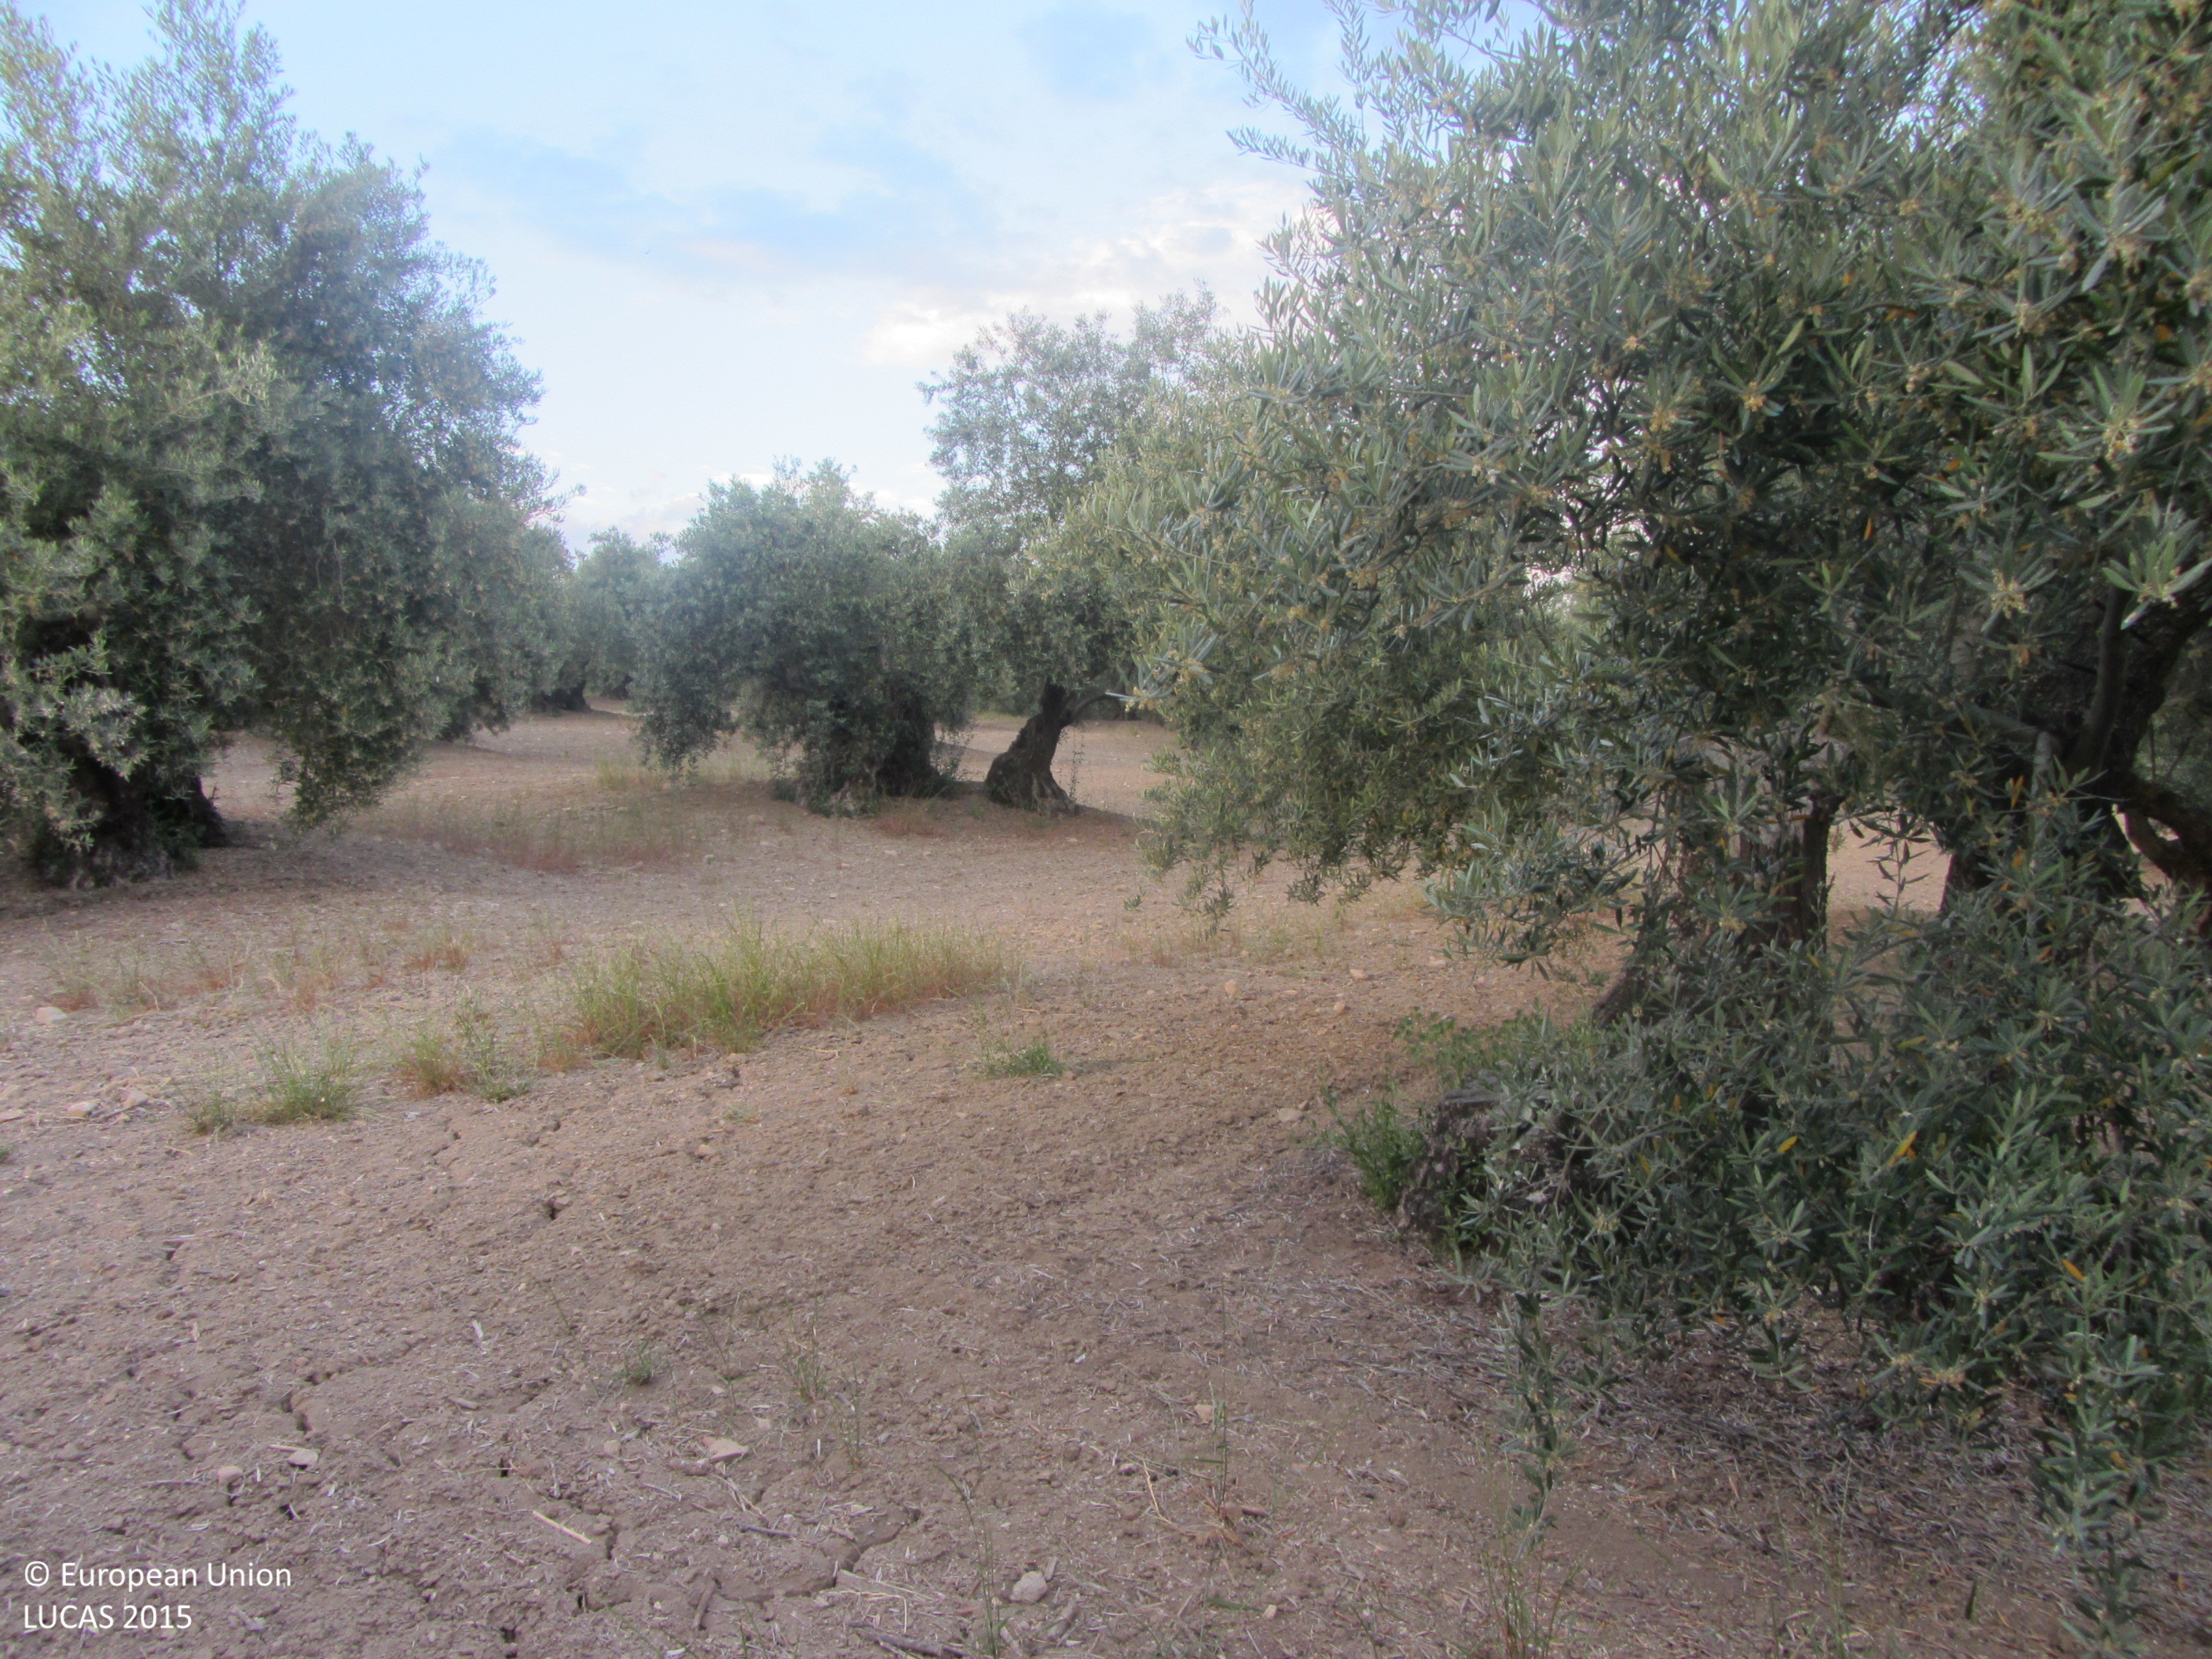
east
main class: Cropland
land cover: Olive groves
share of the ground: 25 - 50 %
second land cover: Other bare soil
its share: > 75 %
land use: Agriculture (excluding fallow land and kitchen gardens)
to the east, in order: Olive groves; Other bare soil
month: May
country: ES
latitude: 38.1442
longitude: -3.0639
